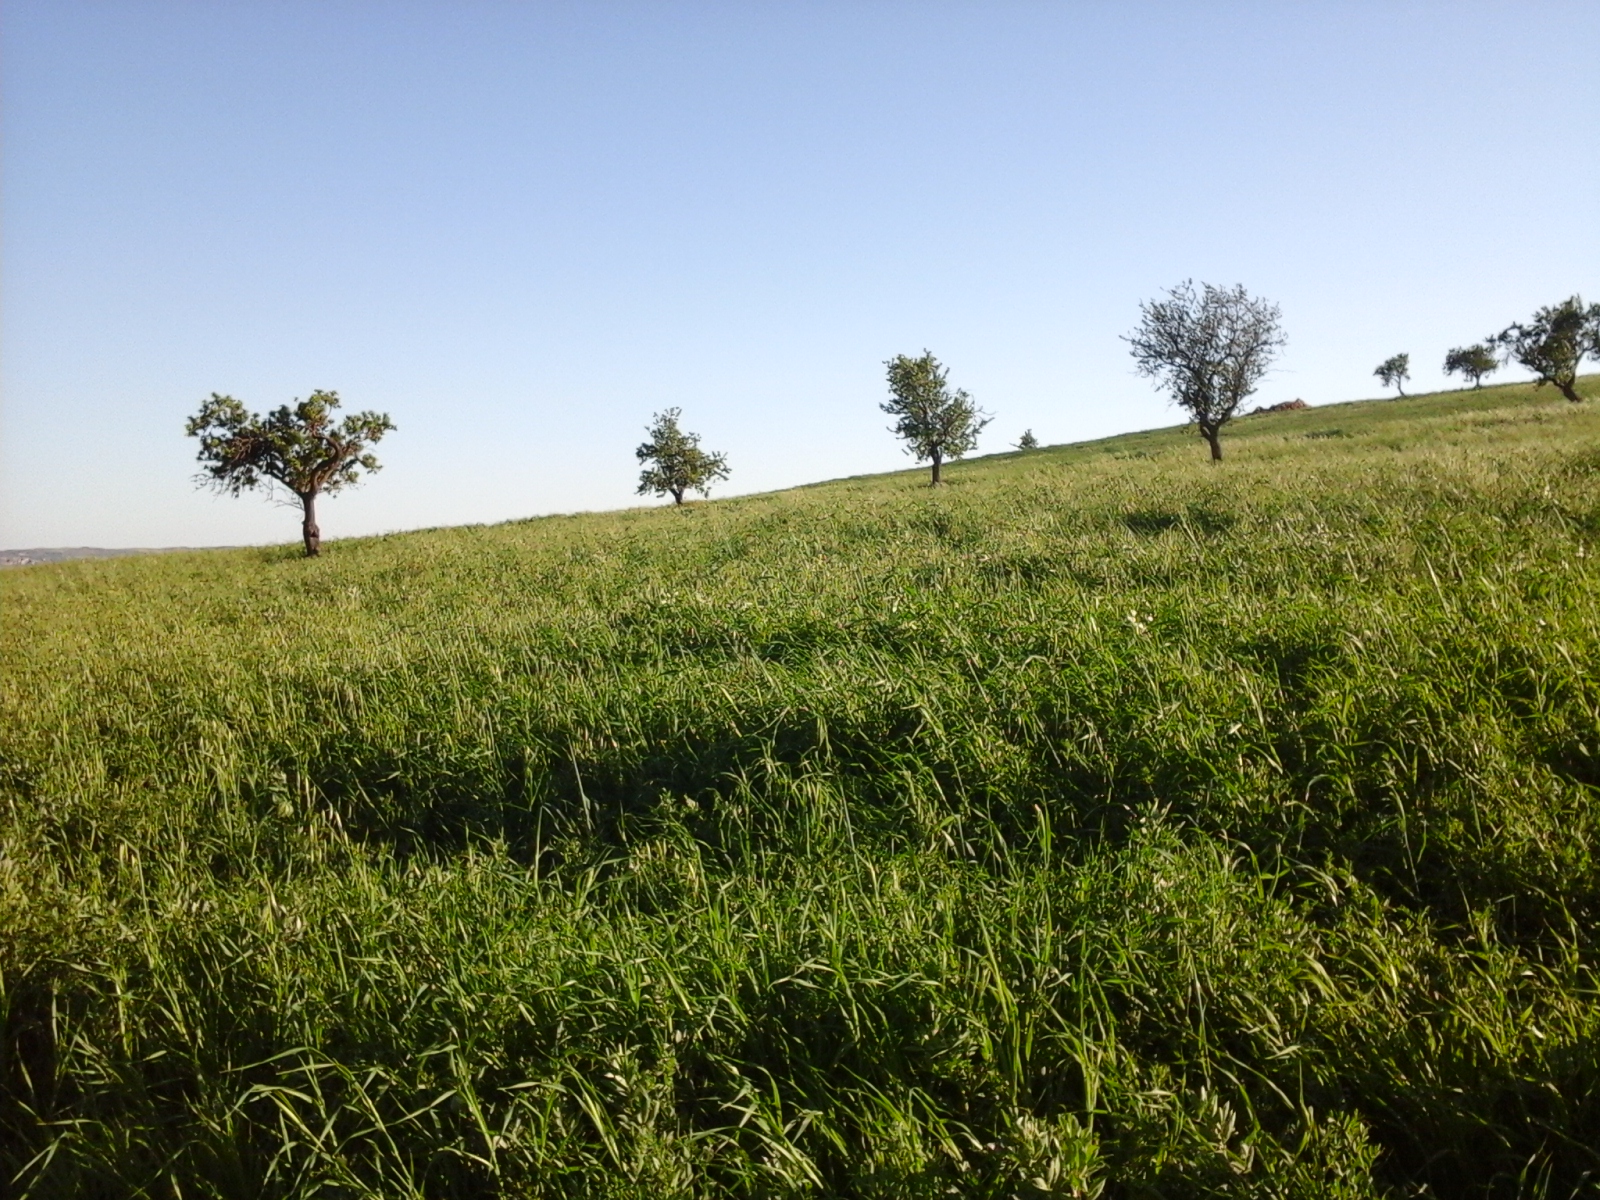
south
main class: Cropland
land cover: Dry pulses
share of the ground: > 75 %
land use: Agriculture (excluding fallow land and kitchen gardens)
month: May
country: IT
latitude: 37.4947
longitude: 14.1203
